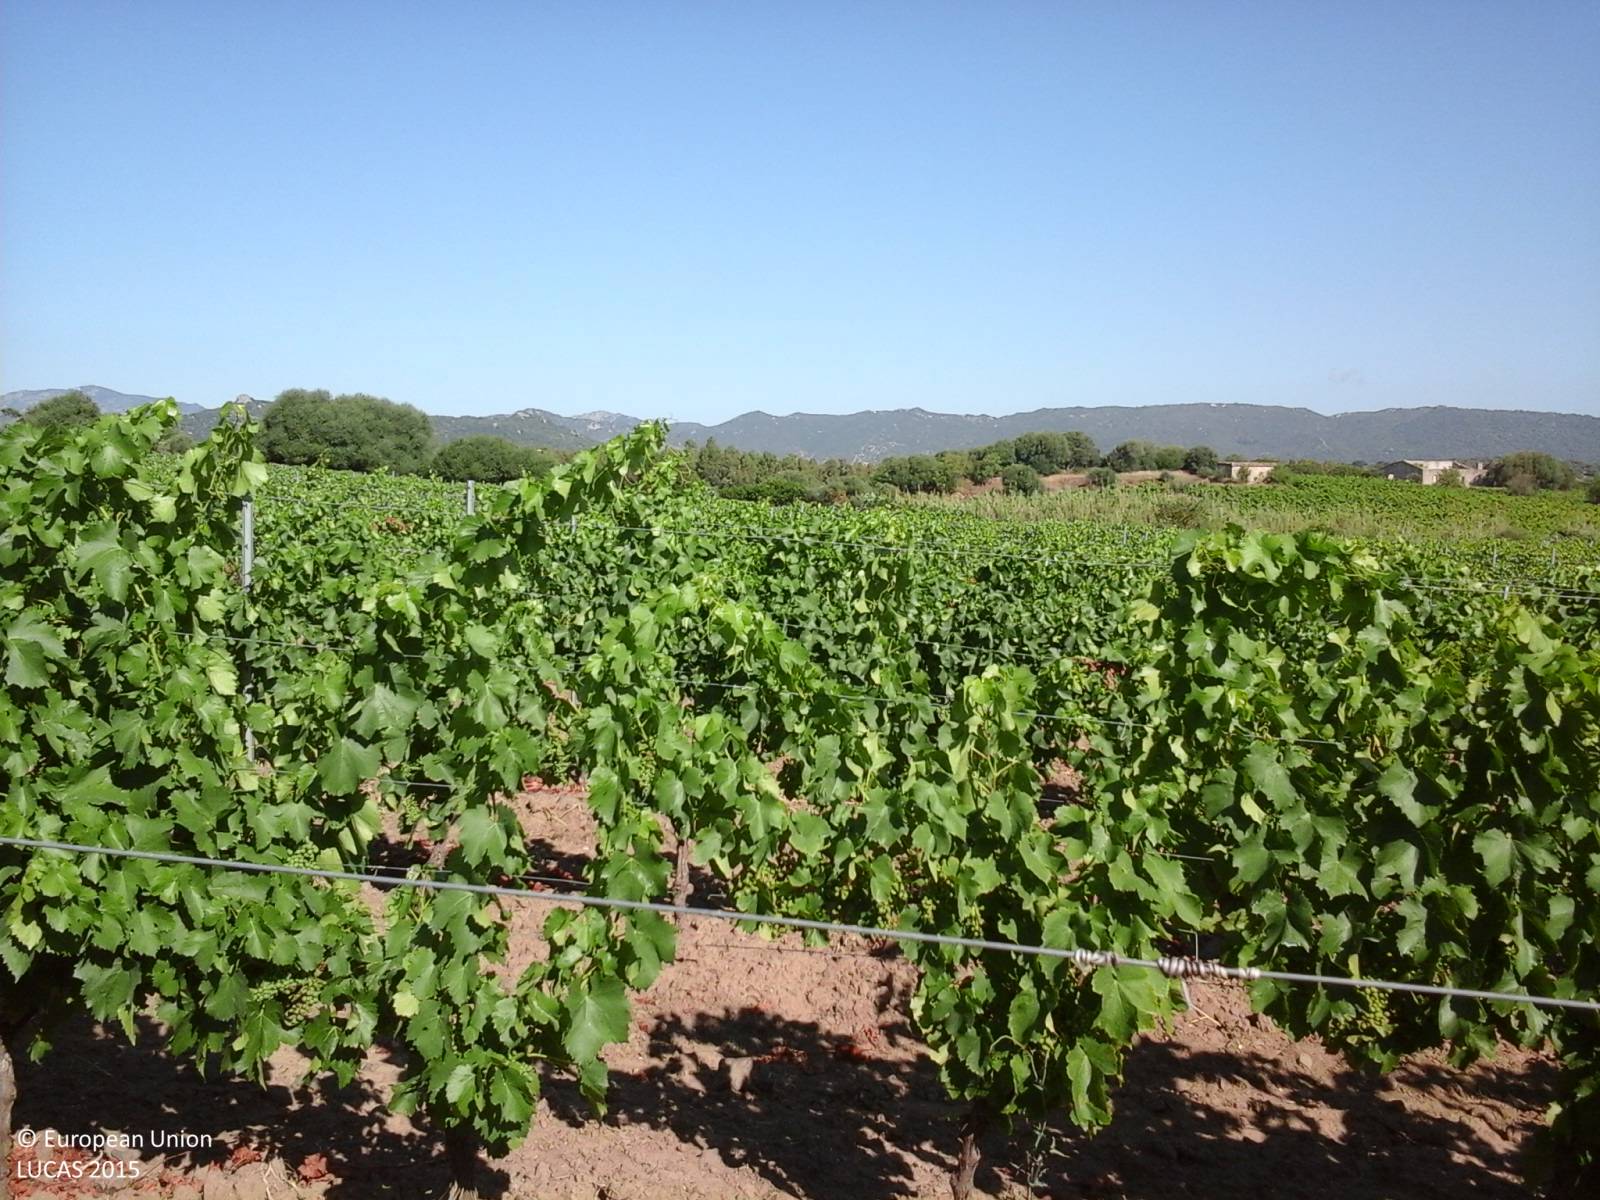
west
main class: Cropland
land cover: Vineyards
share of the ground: > 75 %
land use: Agriculture (excluding fallow land and kitchen gardens)
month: June
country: IT
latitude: 40.3205
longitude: 9.5200
